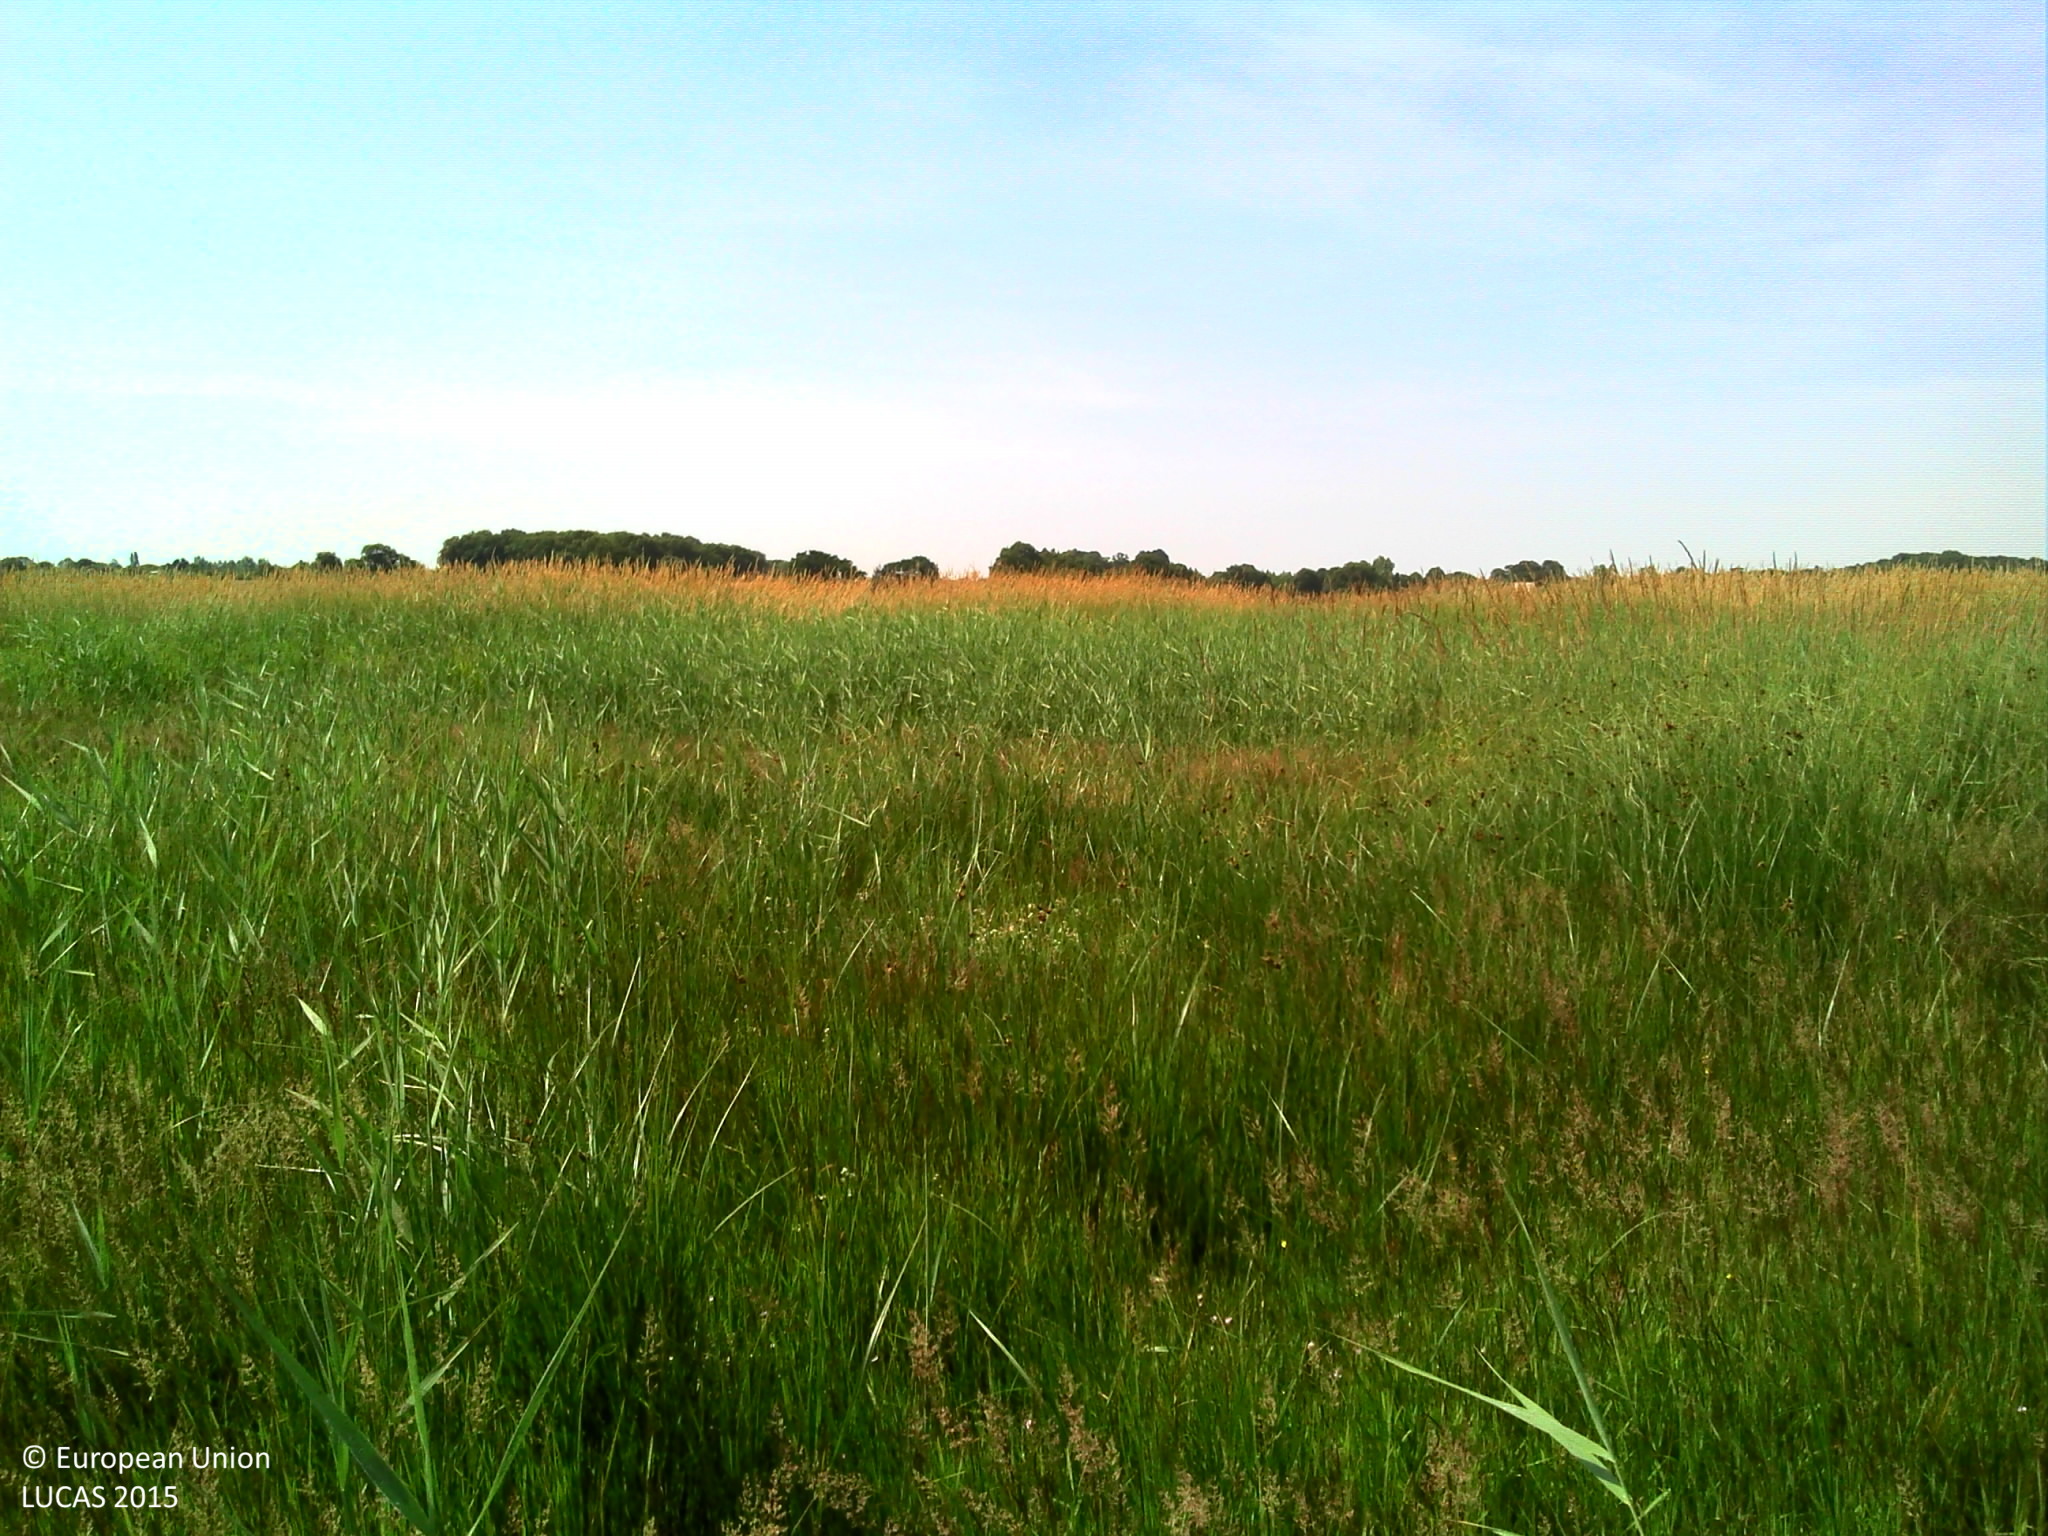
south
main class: Grassland
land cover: Grassland without tree/shrub cover
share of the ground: > 75 %
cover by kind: herbaceous plants 100 %
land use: Agriculture (excluding fallow land and kitchen gardens)
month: June
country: FR
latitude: 47.3558
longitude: -2.0844
